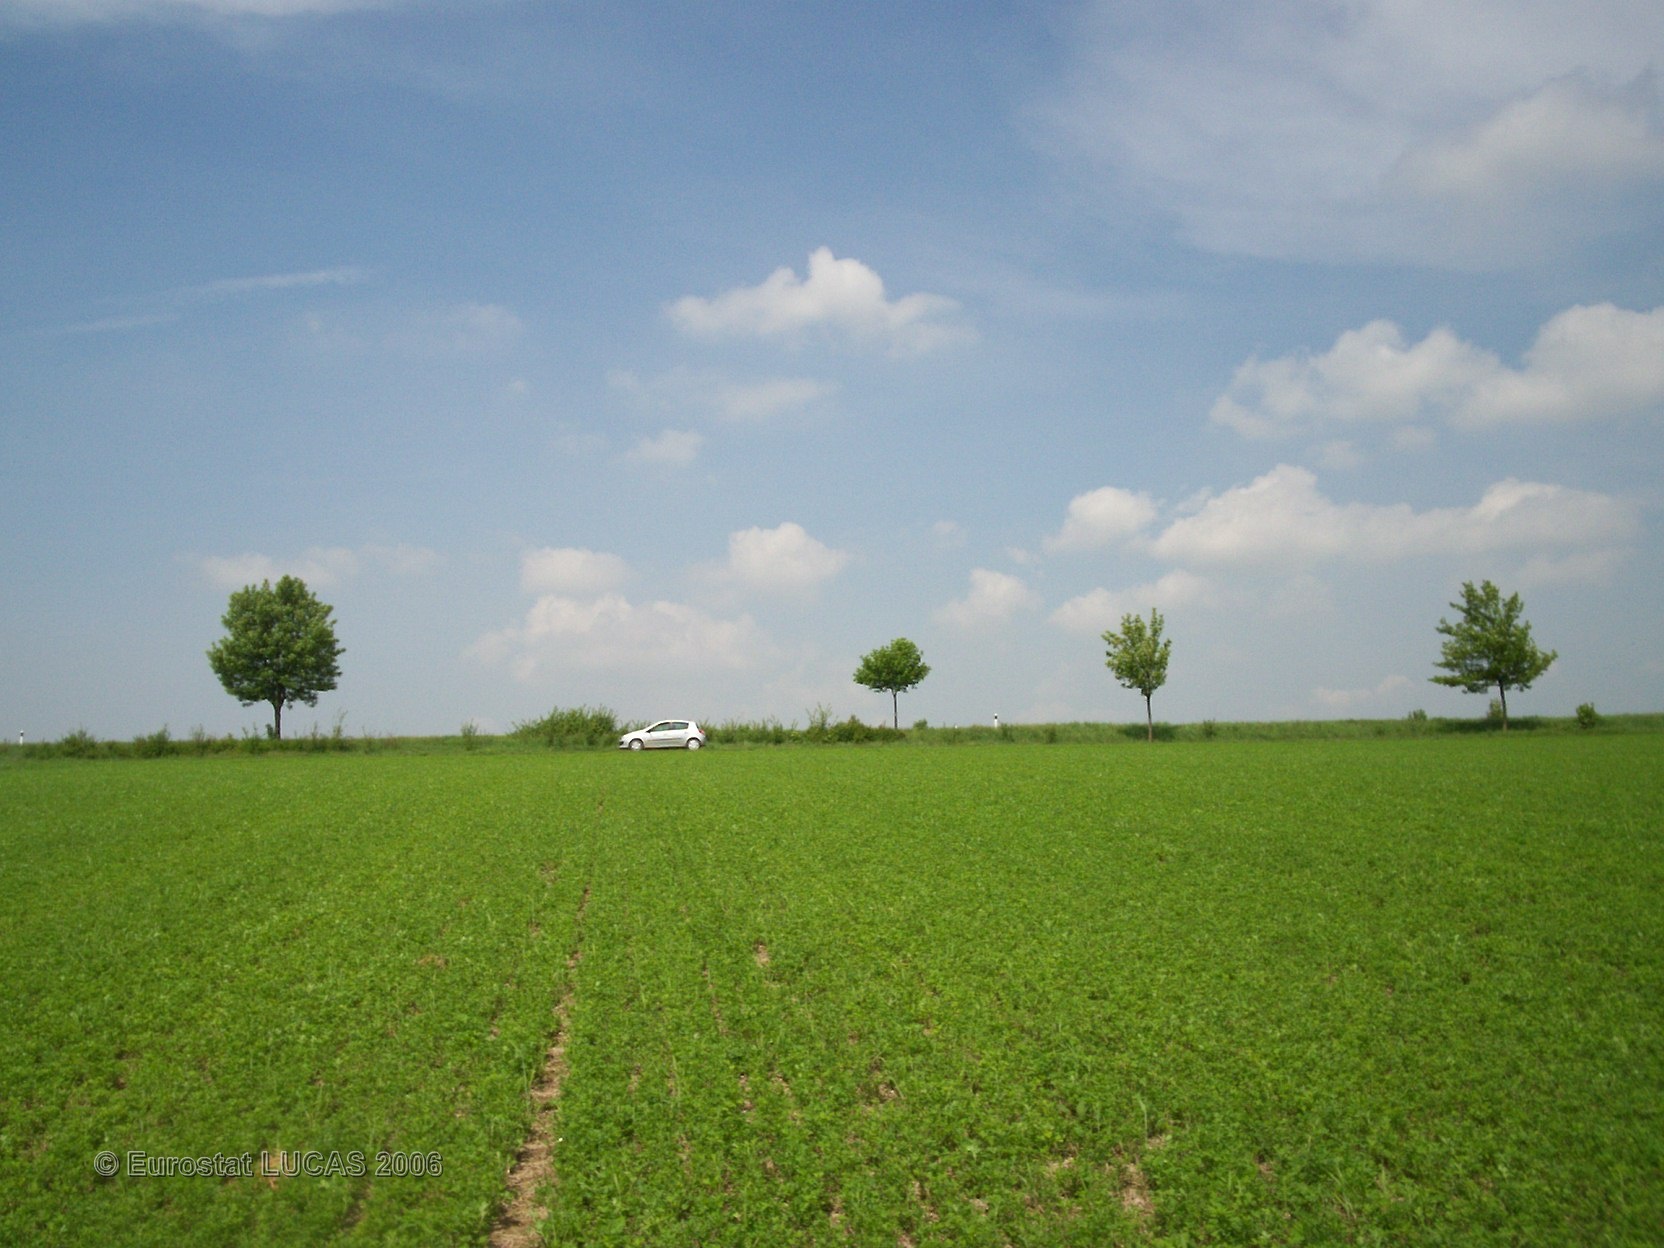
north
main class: Cropland
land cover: Lucerne
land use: Agriculture (excluding fallow land and kitchen gardens)
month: May
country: FR
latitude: 48.9654
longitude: 4.4098
